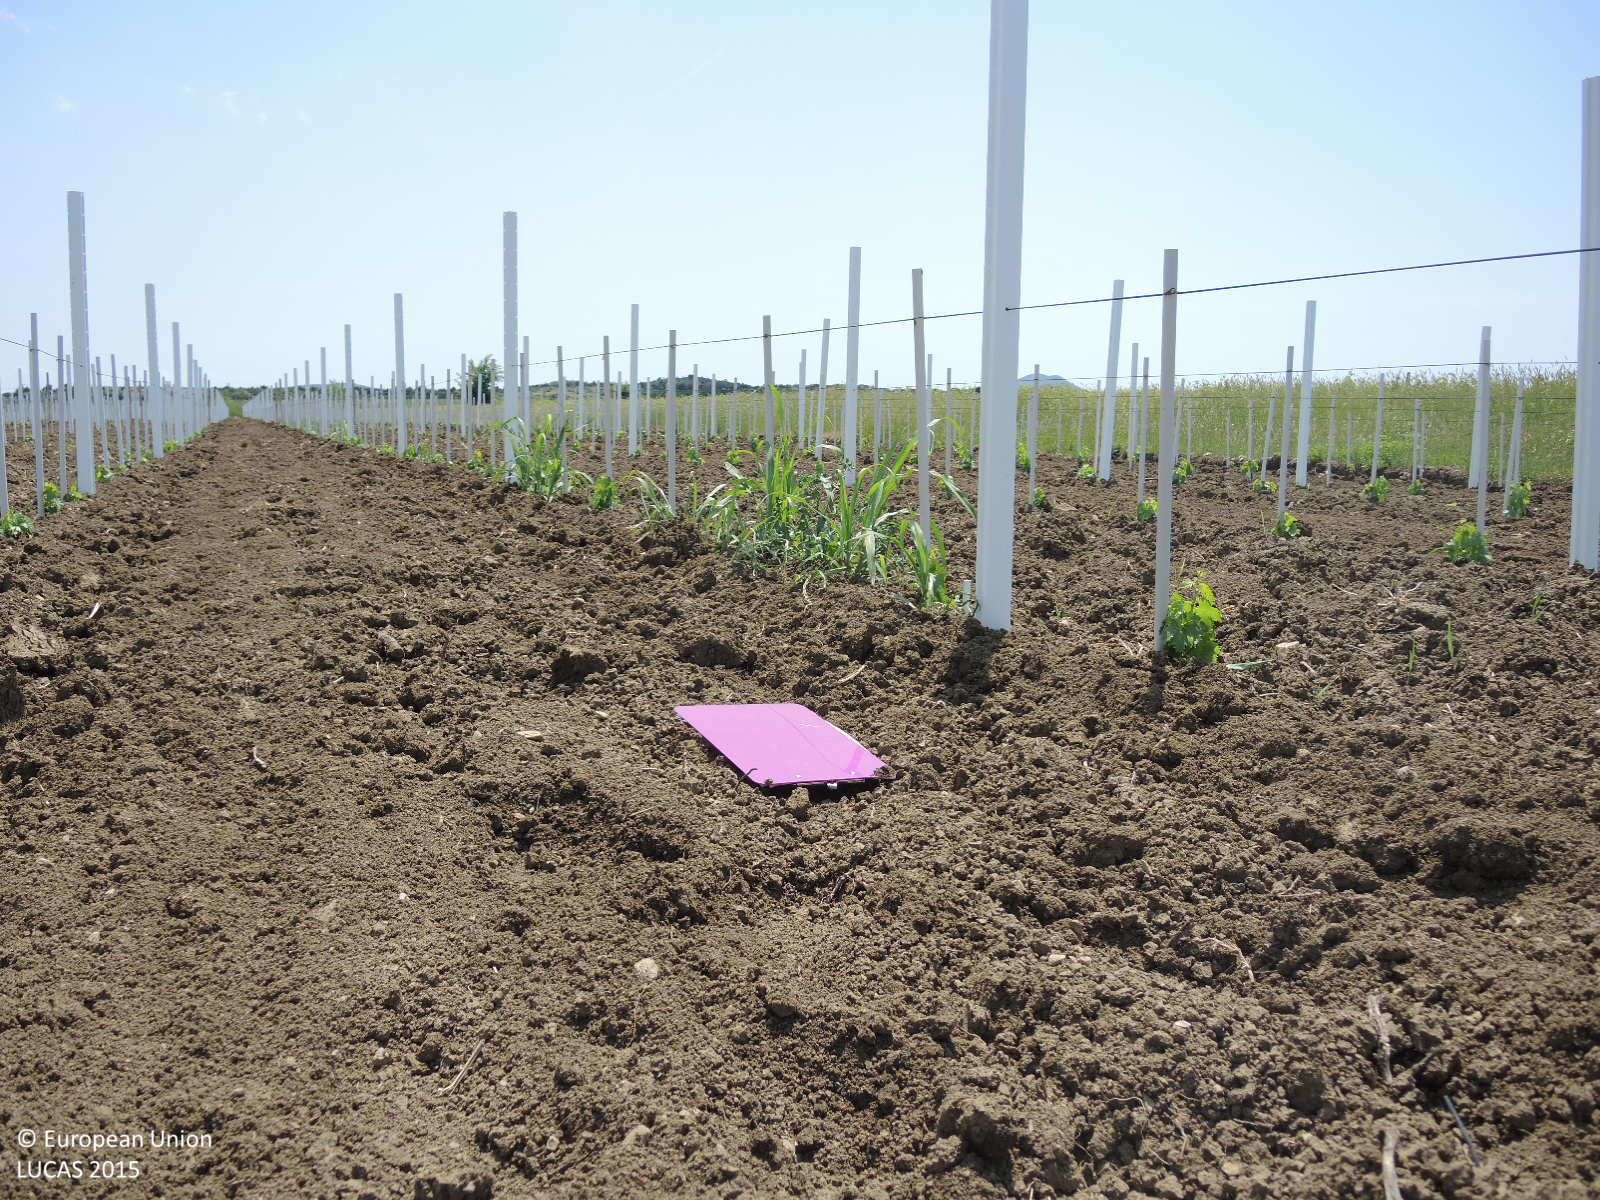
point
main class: Cropland
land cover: Vineyards
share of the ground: < 10 %
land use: Agriculture (excluding fallow land and kitchen gardens)
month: May
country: HR
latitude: 44.0423
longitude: 15.4954
